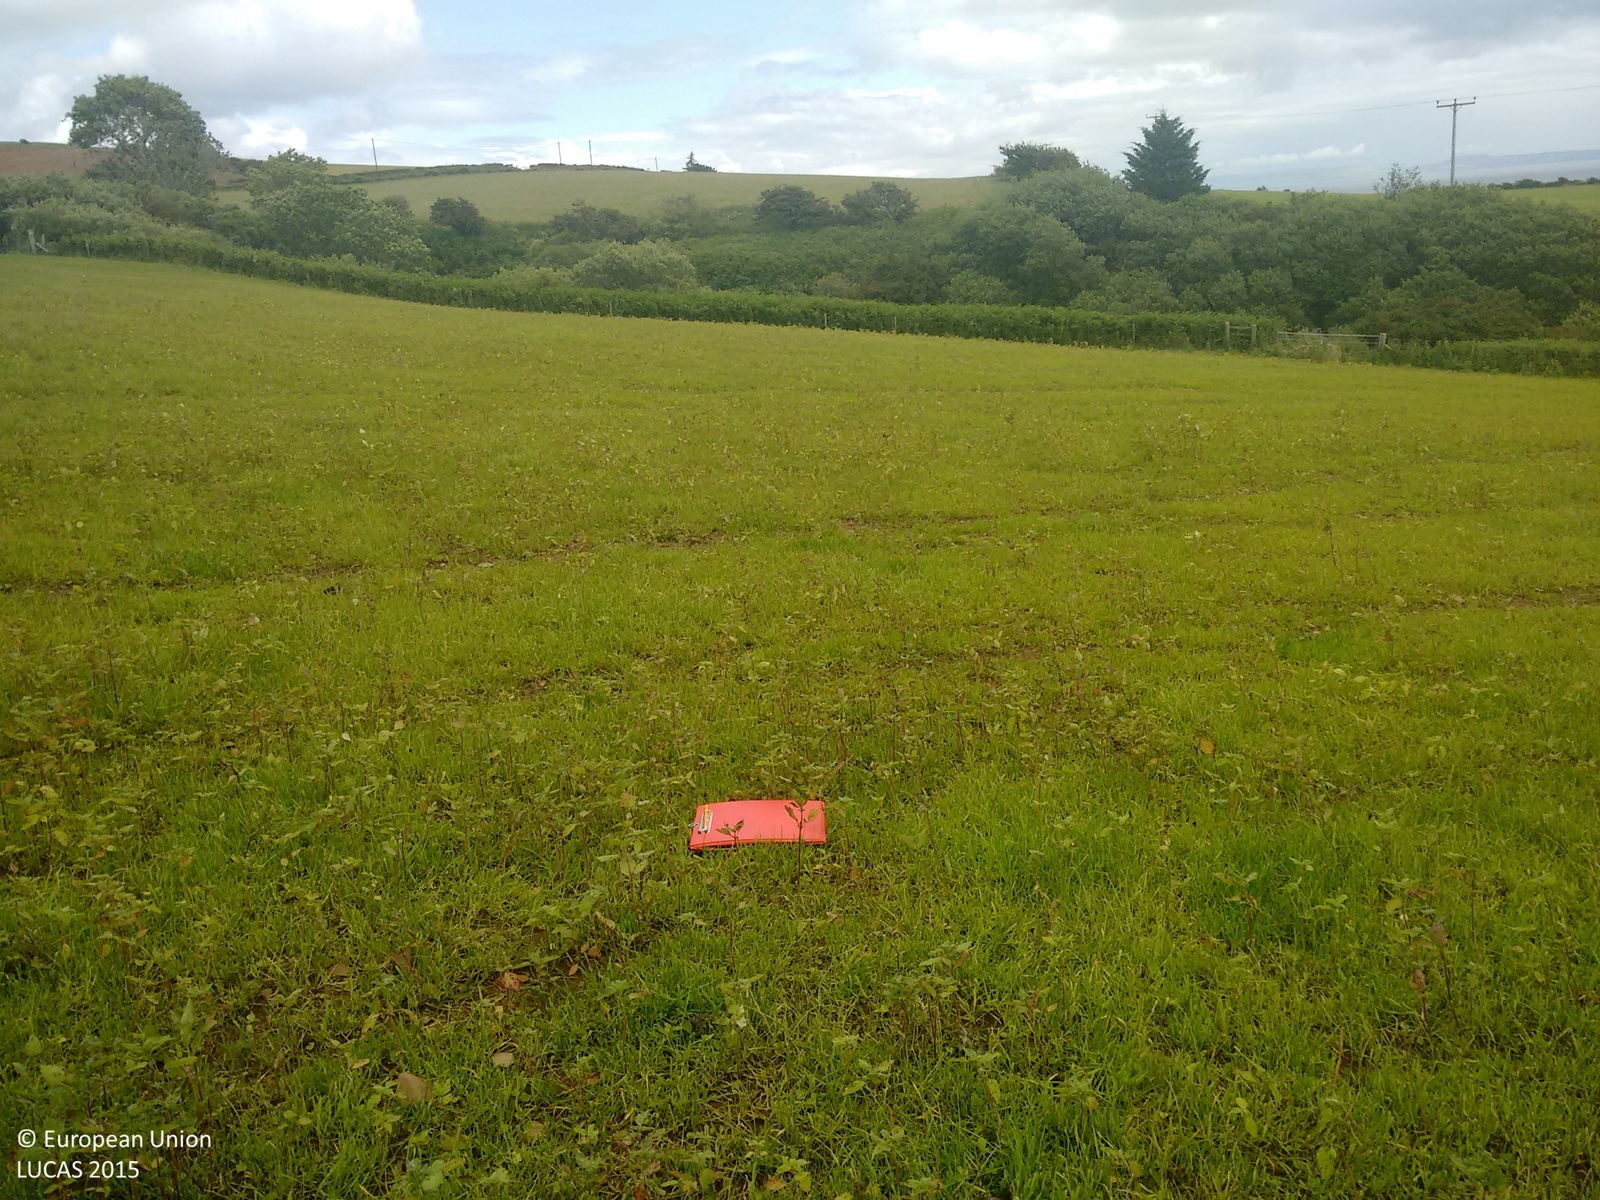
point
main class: Grassland
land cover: Grassland without tree/shrub cover
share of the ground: > 75 %
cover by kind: herbaceous plants 100 %
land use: Agriculture (excluding fallow land and kitchen gardens)
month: July
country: GB
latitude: 55.4456
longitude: -5.1499
